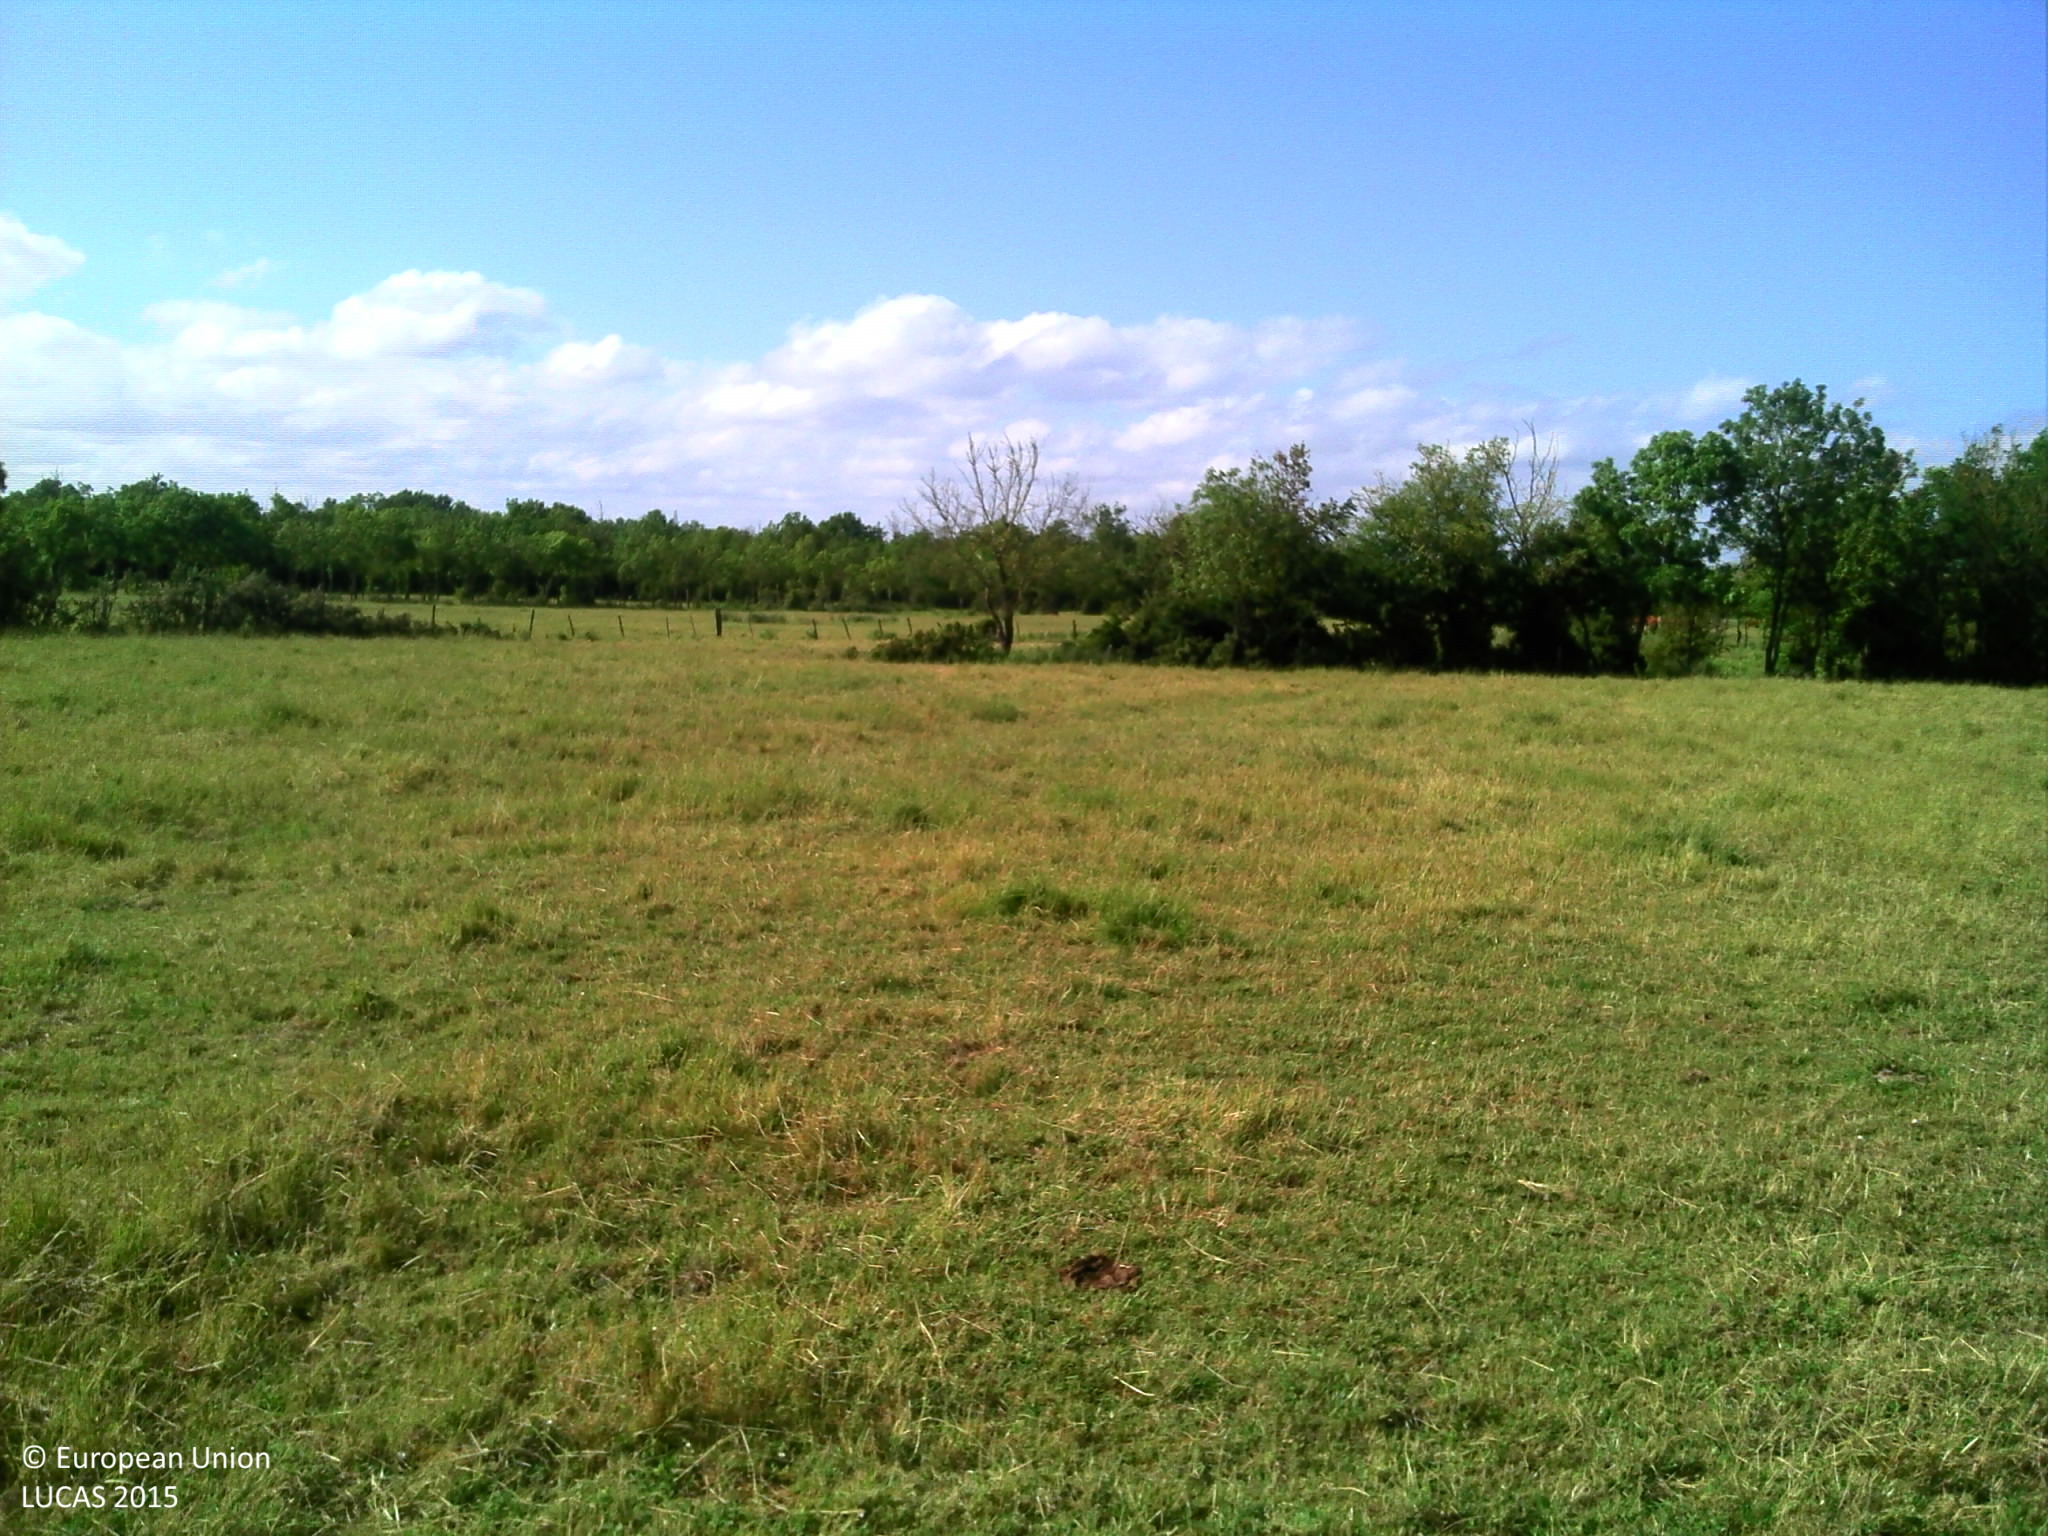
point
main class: Grassland
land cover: Grassland without tree/shrub cover
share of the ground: > 75 %
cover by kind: herbaceous plants 100 %
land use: Agriculture (excluding fallow land and kitchen gardens)
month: June
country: FR
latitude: 46.2731
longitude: -0.9958
